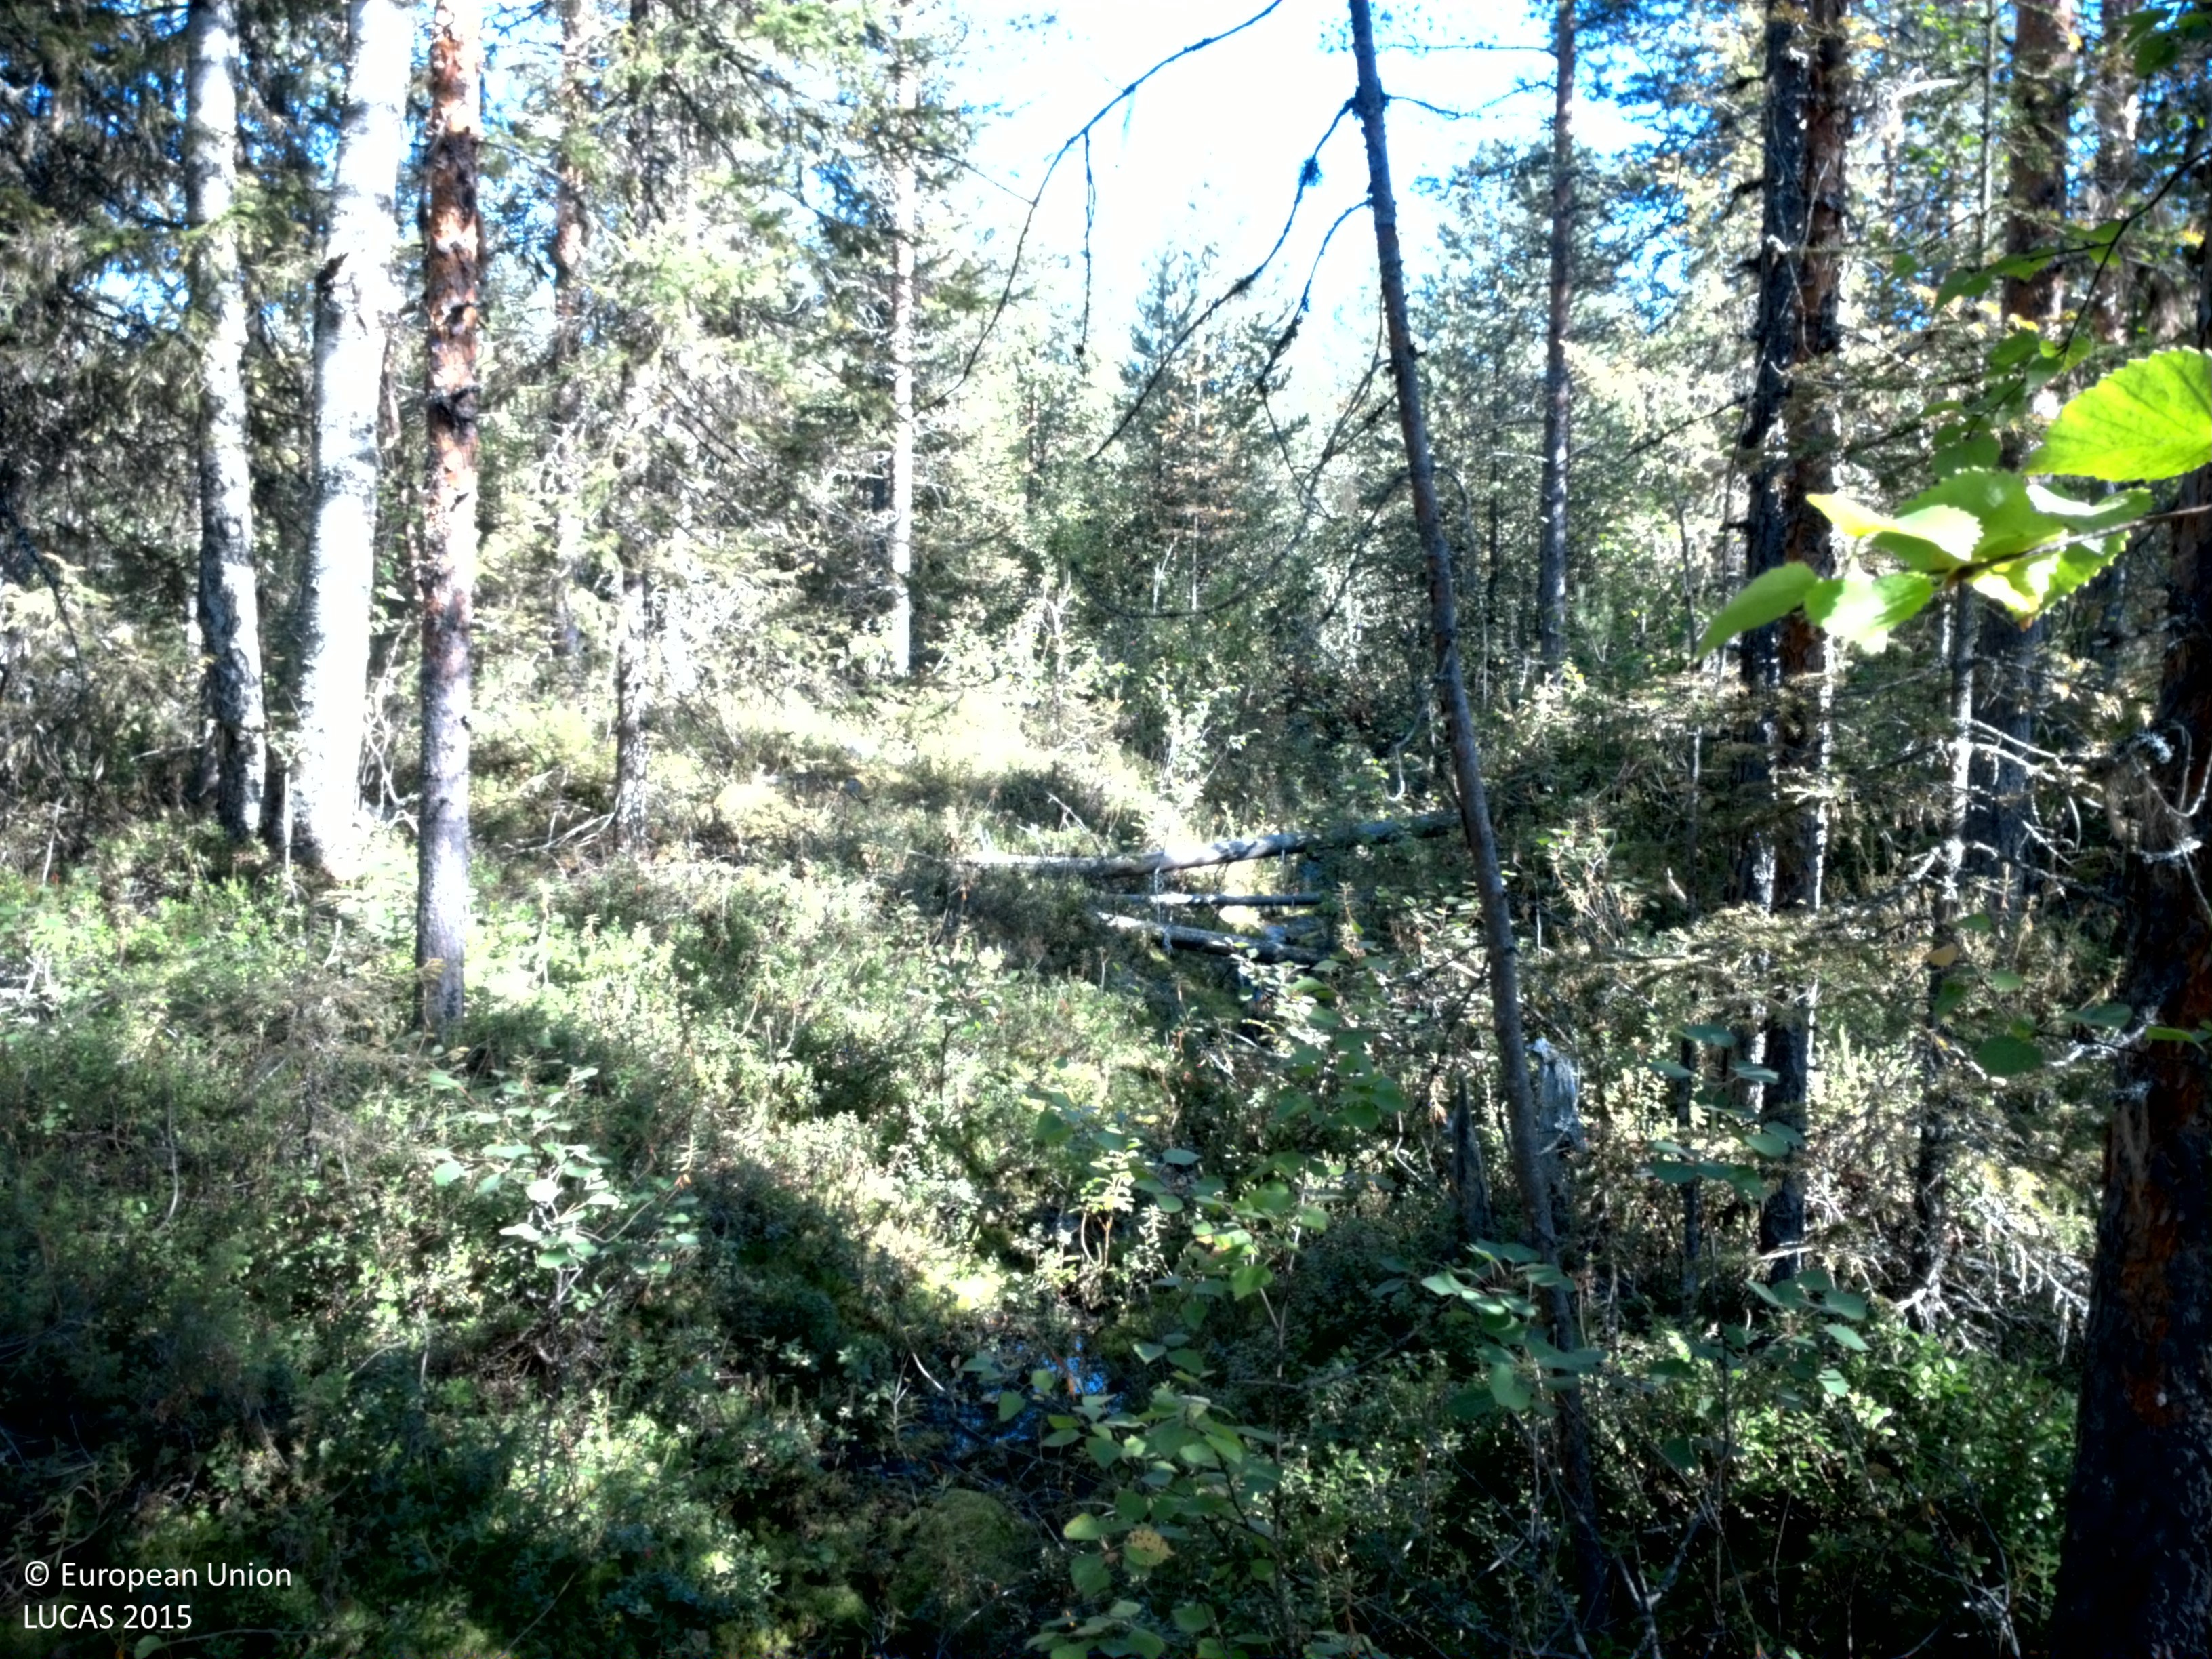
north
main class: Woodland
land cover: Pine dominated coniferous woodland
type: boreal forest
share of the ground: 25 - 50 %
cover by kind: shrubs 60 %, coniferous forest trees 35 %, broadleaved forest trees 5 %
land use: Forestry
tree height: > 5 m
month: August
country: SE
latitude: 66.2342
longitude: 20.6114
